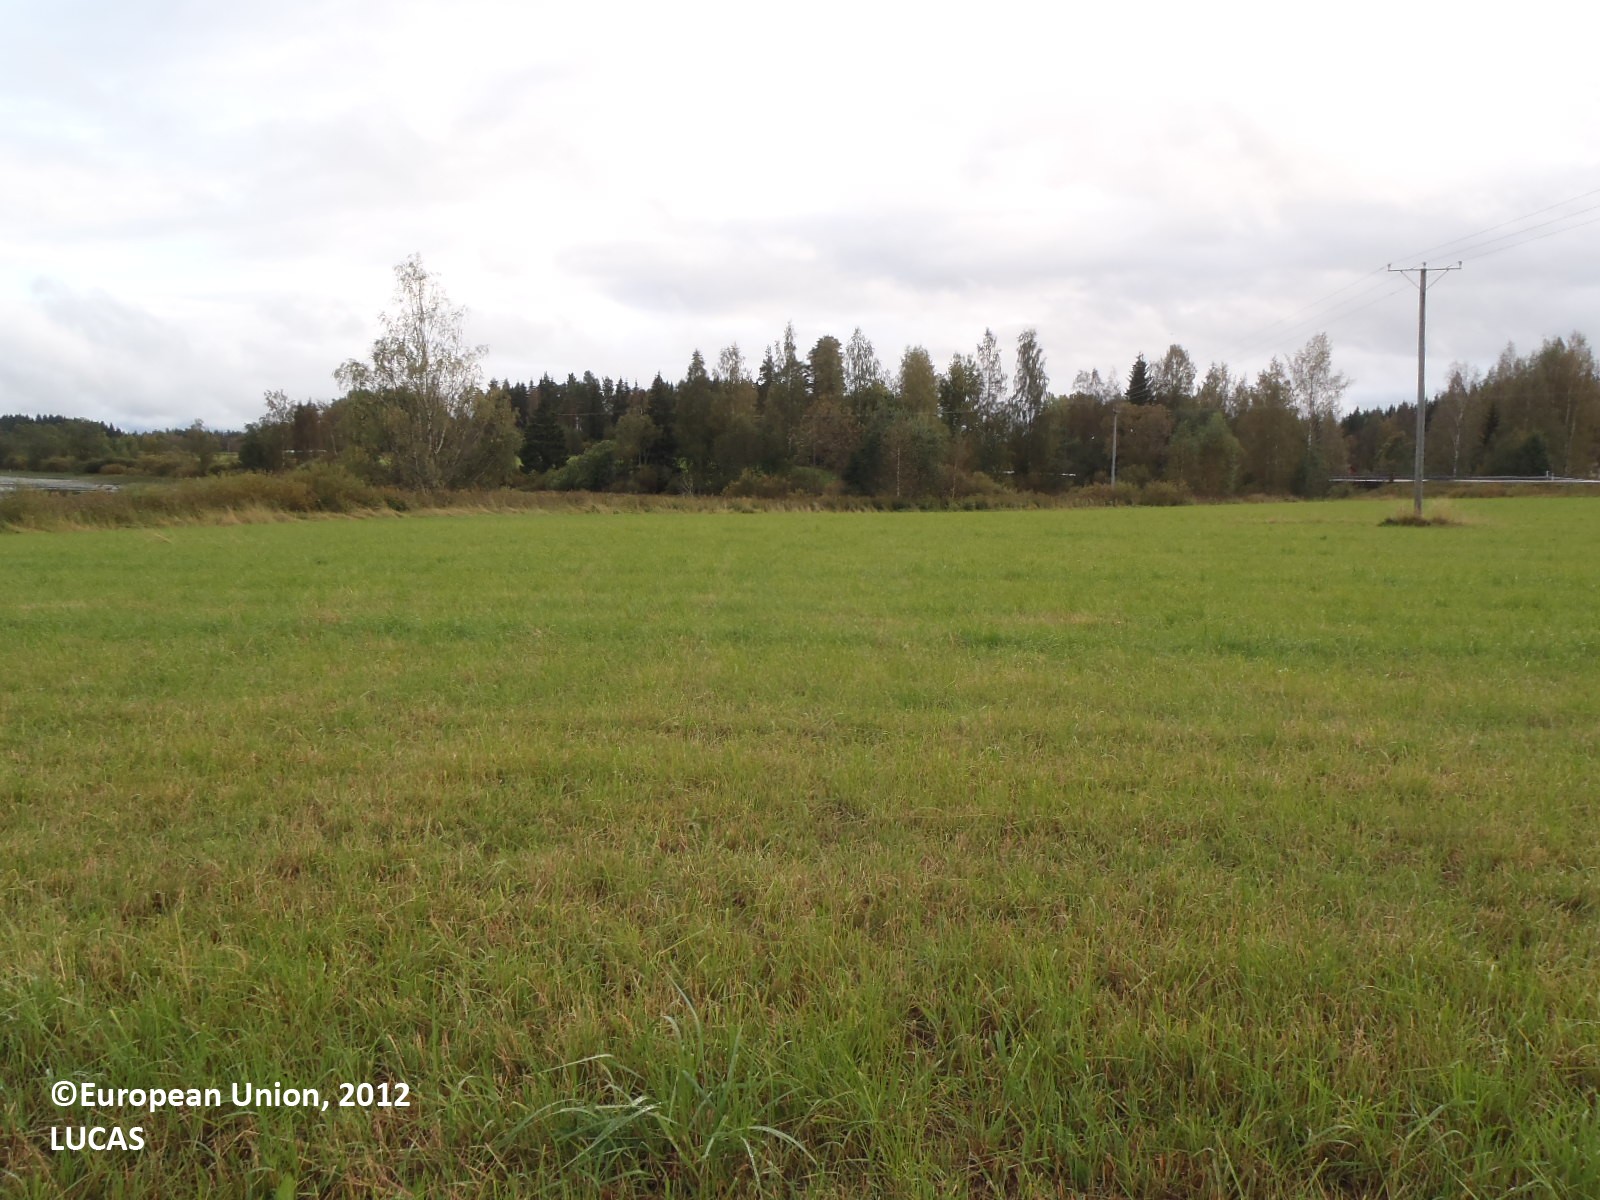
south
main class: Cropland
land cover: Temporary grasslands
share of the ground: > 75 %
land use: Agriculture (excluding fallow land and kitchen gardens)
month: September
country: FI
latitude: 61.6820
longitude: 22.5539
